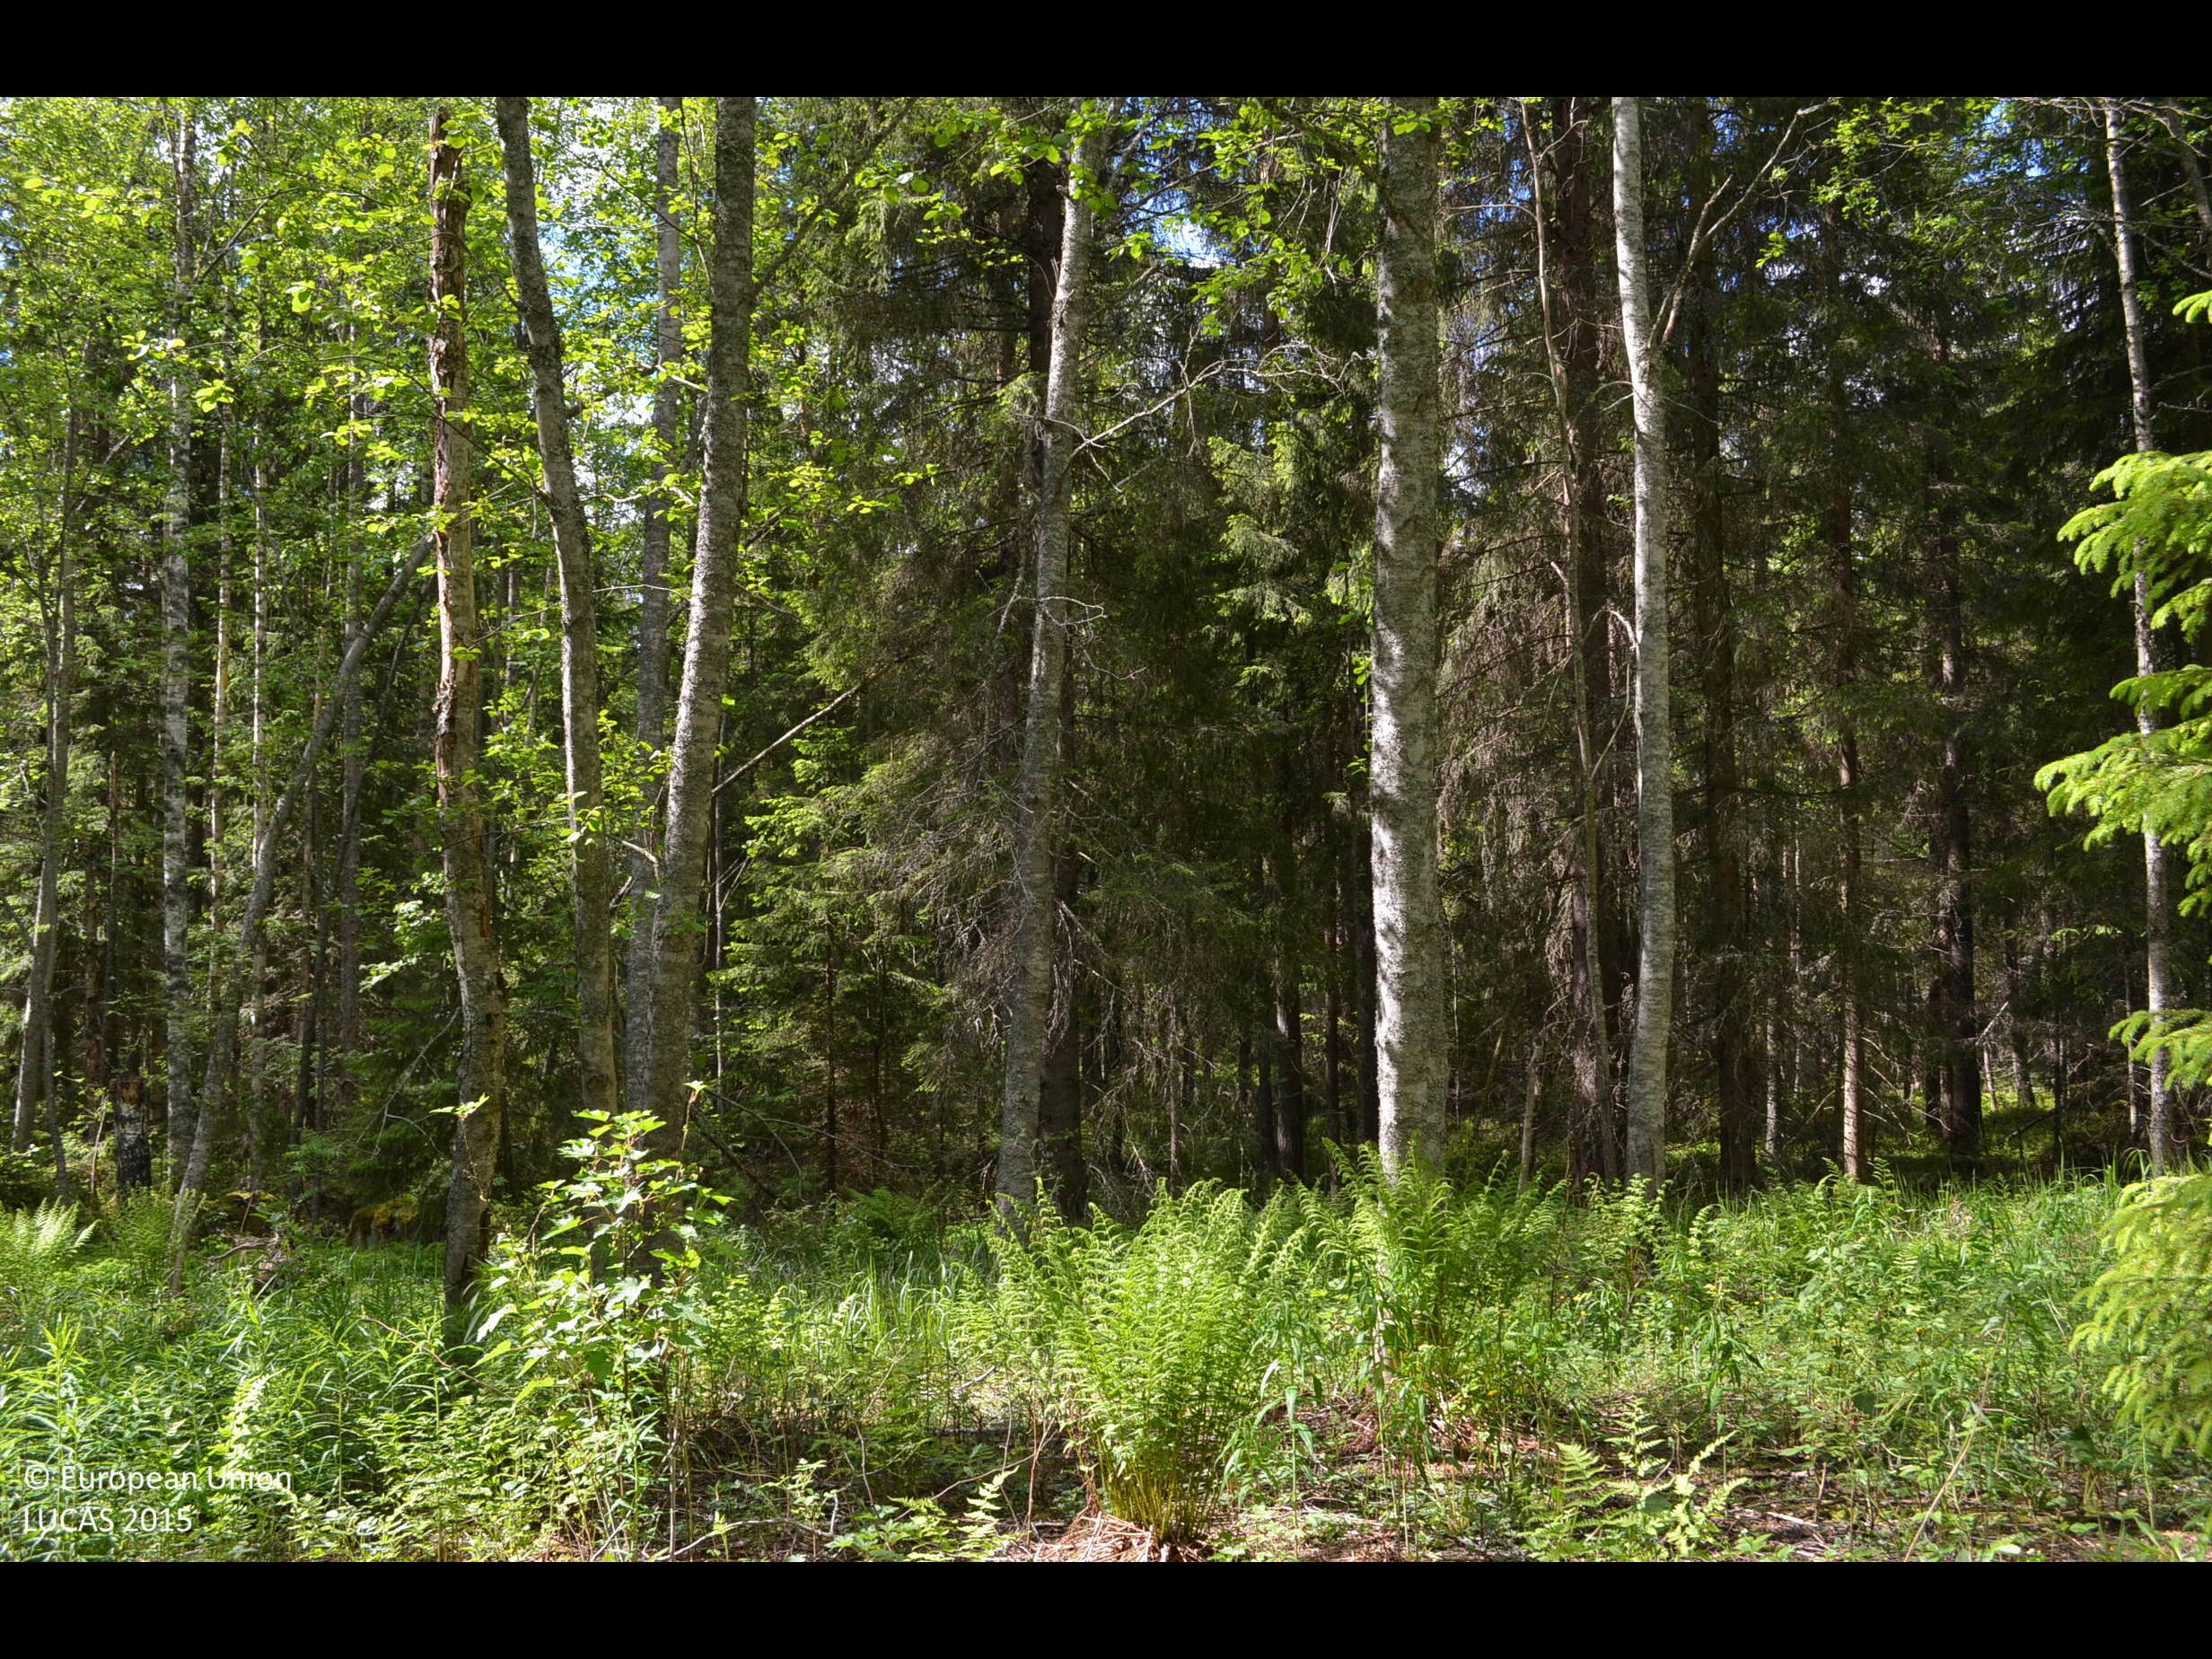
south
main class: Woodland
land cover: Spruce dominated mixed woodland
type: boreal forest
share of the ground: > 75 %
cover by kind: coniferous forest trees 40 %, broadleaved forest trees 40 %, herbaceous plants 20 %
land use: Forestry
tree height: > 5 m
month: June
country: FI
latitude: 61.9622
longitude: 23.5205
